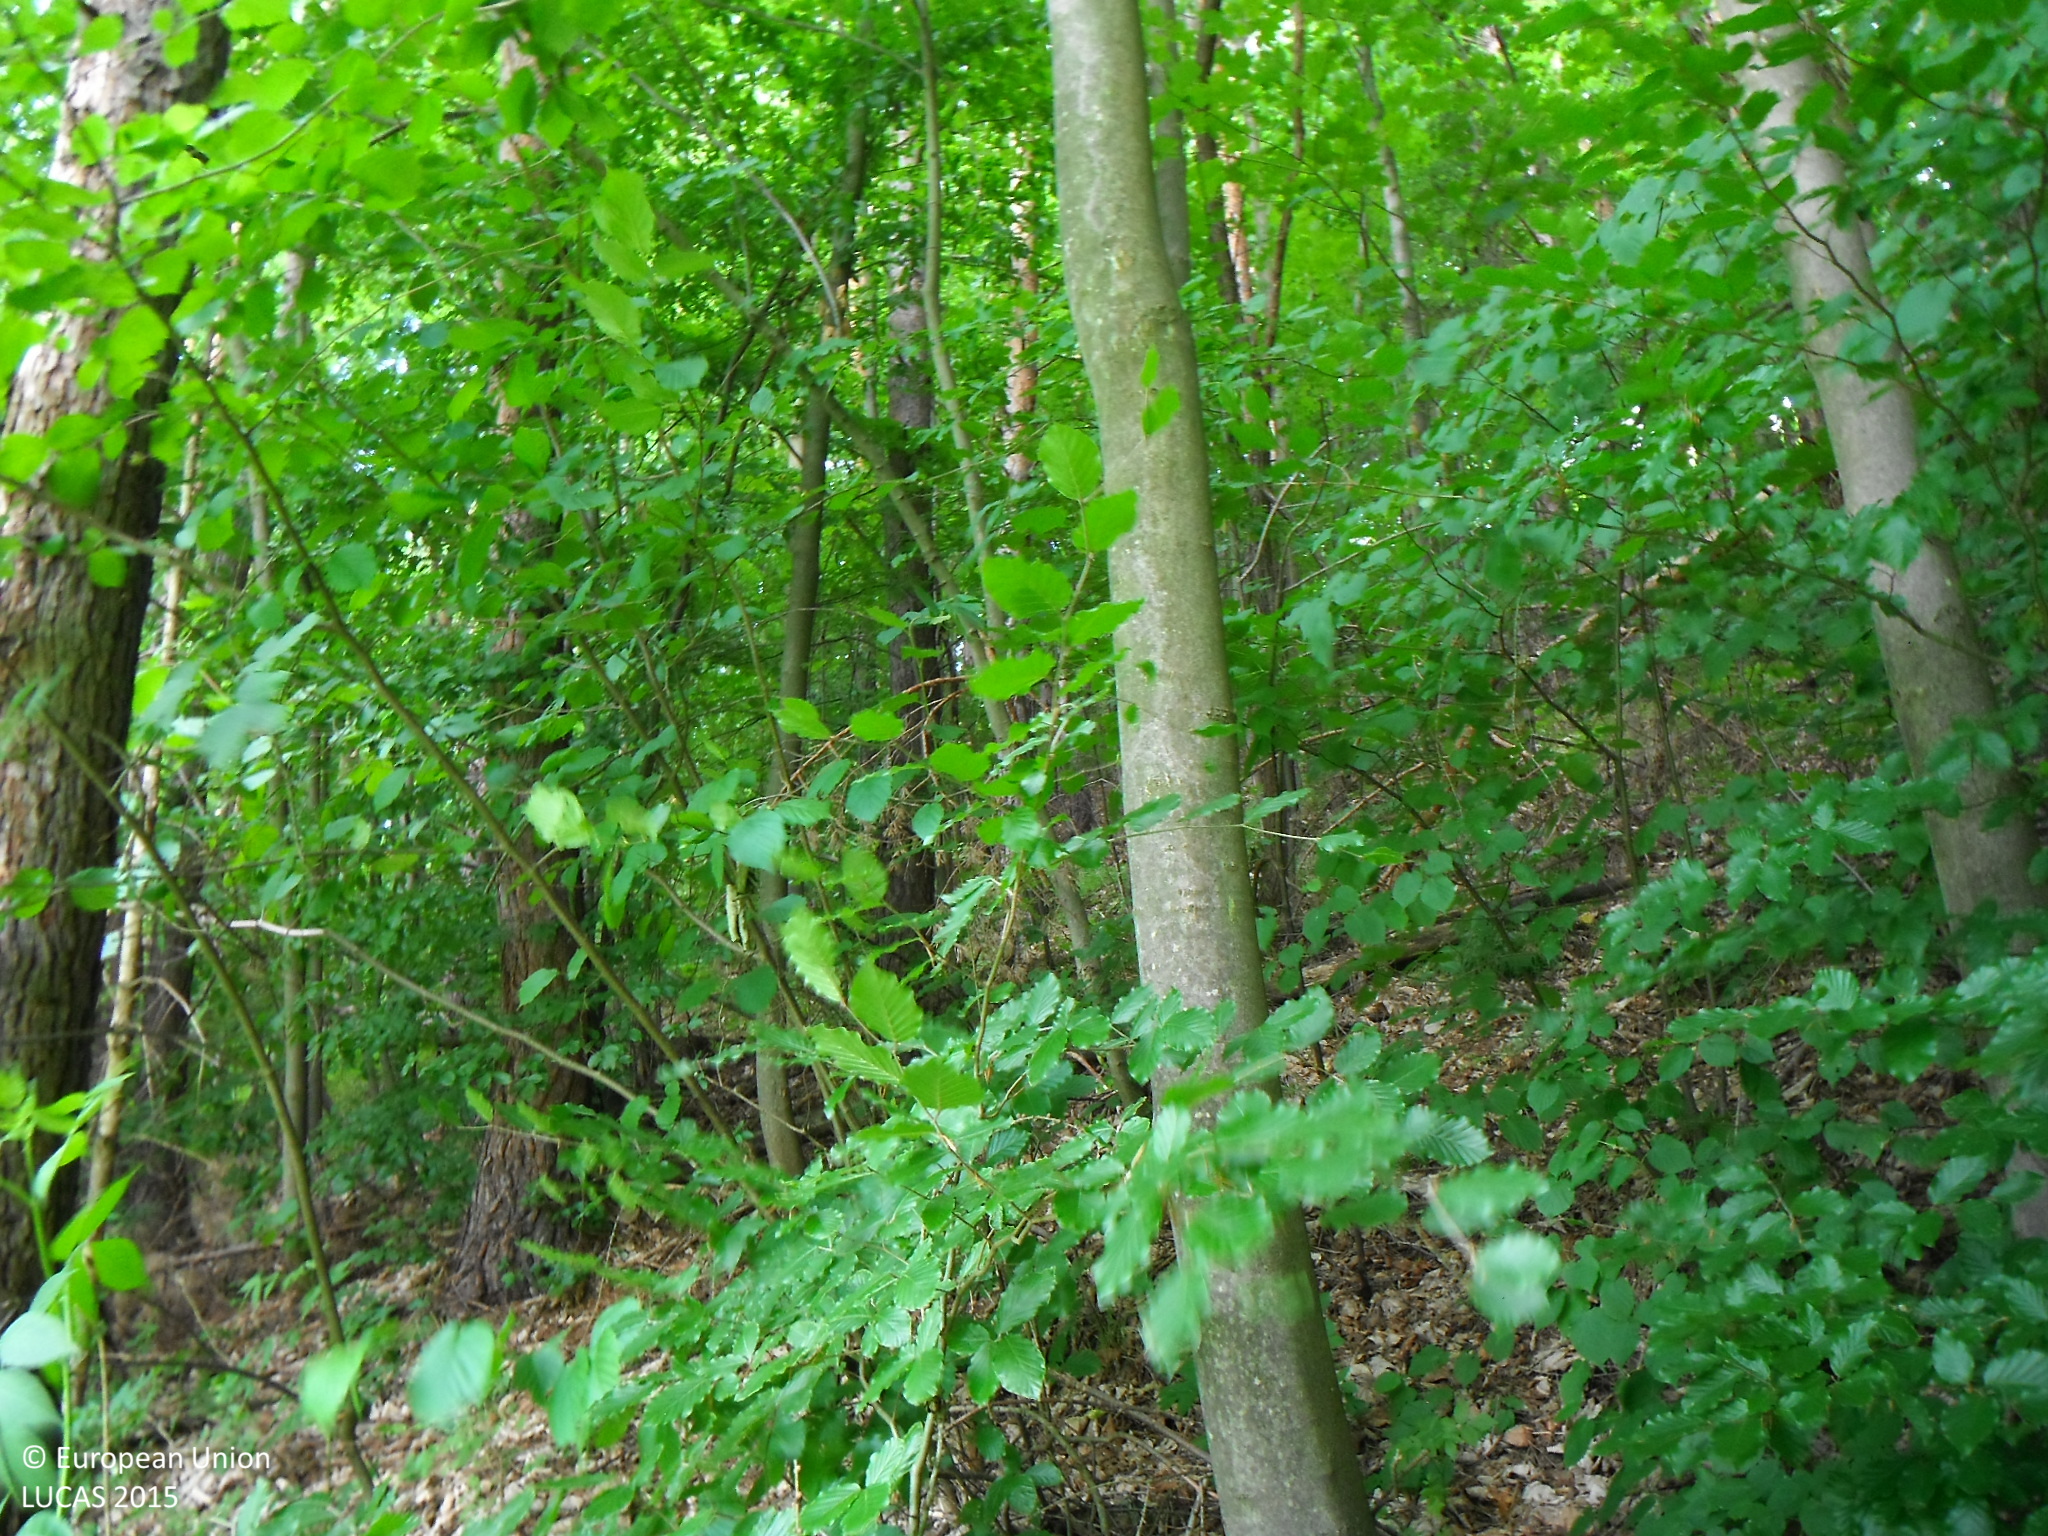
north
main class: Woodland
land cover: Pine dominated mixed woodland
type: hemiboreal forest and nemoral coniferous forest and mixed broadleaved-coniferous forest
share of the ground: > 75 %
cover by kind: broadleaved forest trees 60 %, coniferous forest trees 40 %
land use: Forestry
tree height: > 5 m
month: June
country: SK
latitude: 48.9568
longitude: 21.0362
